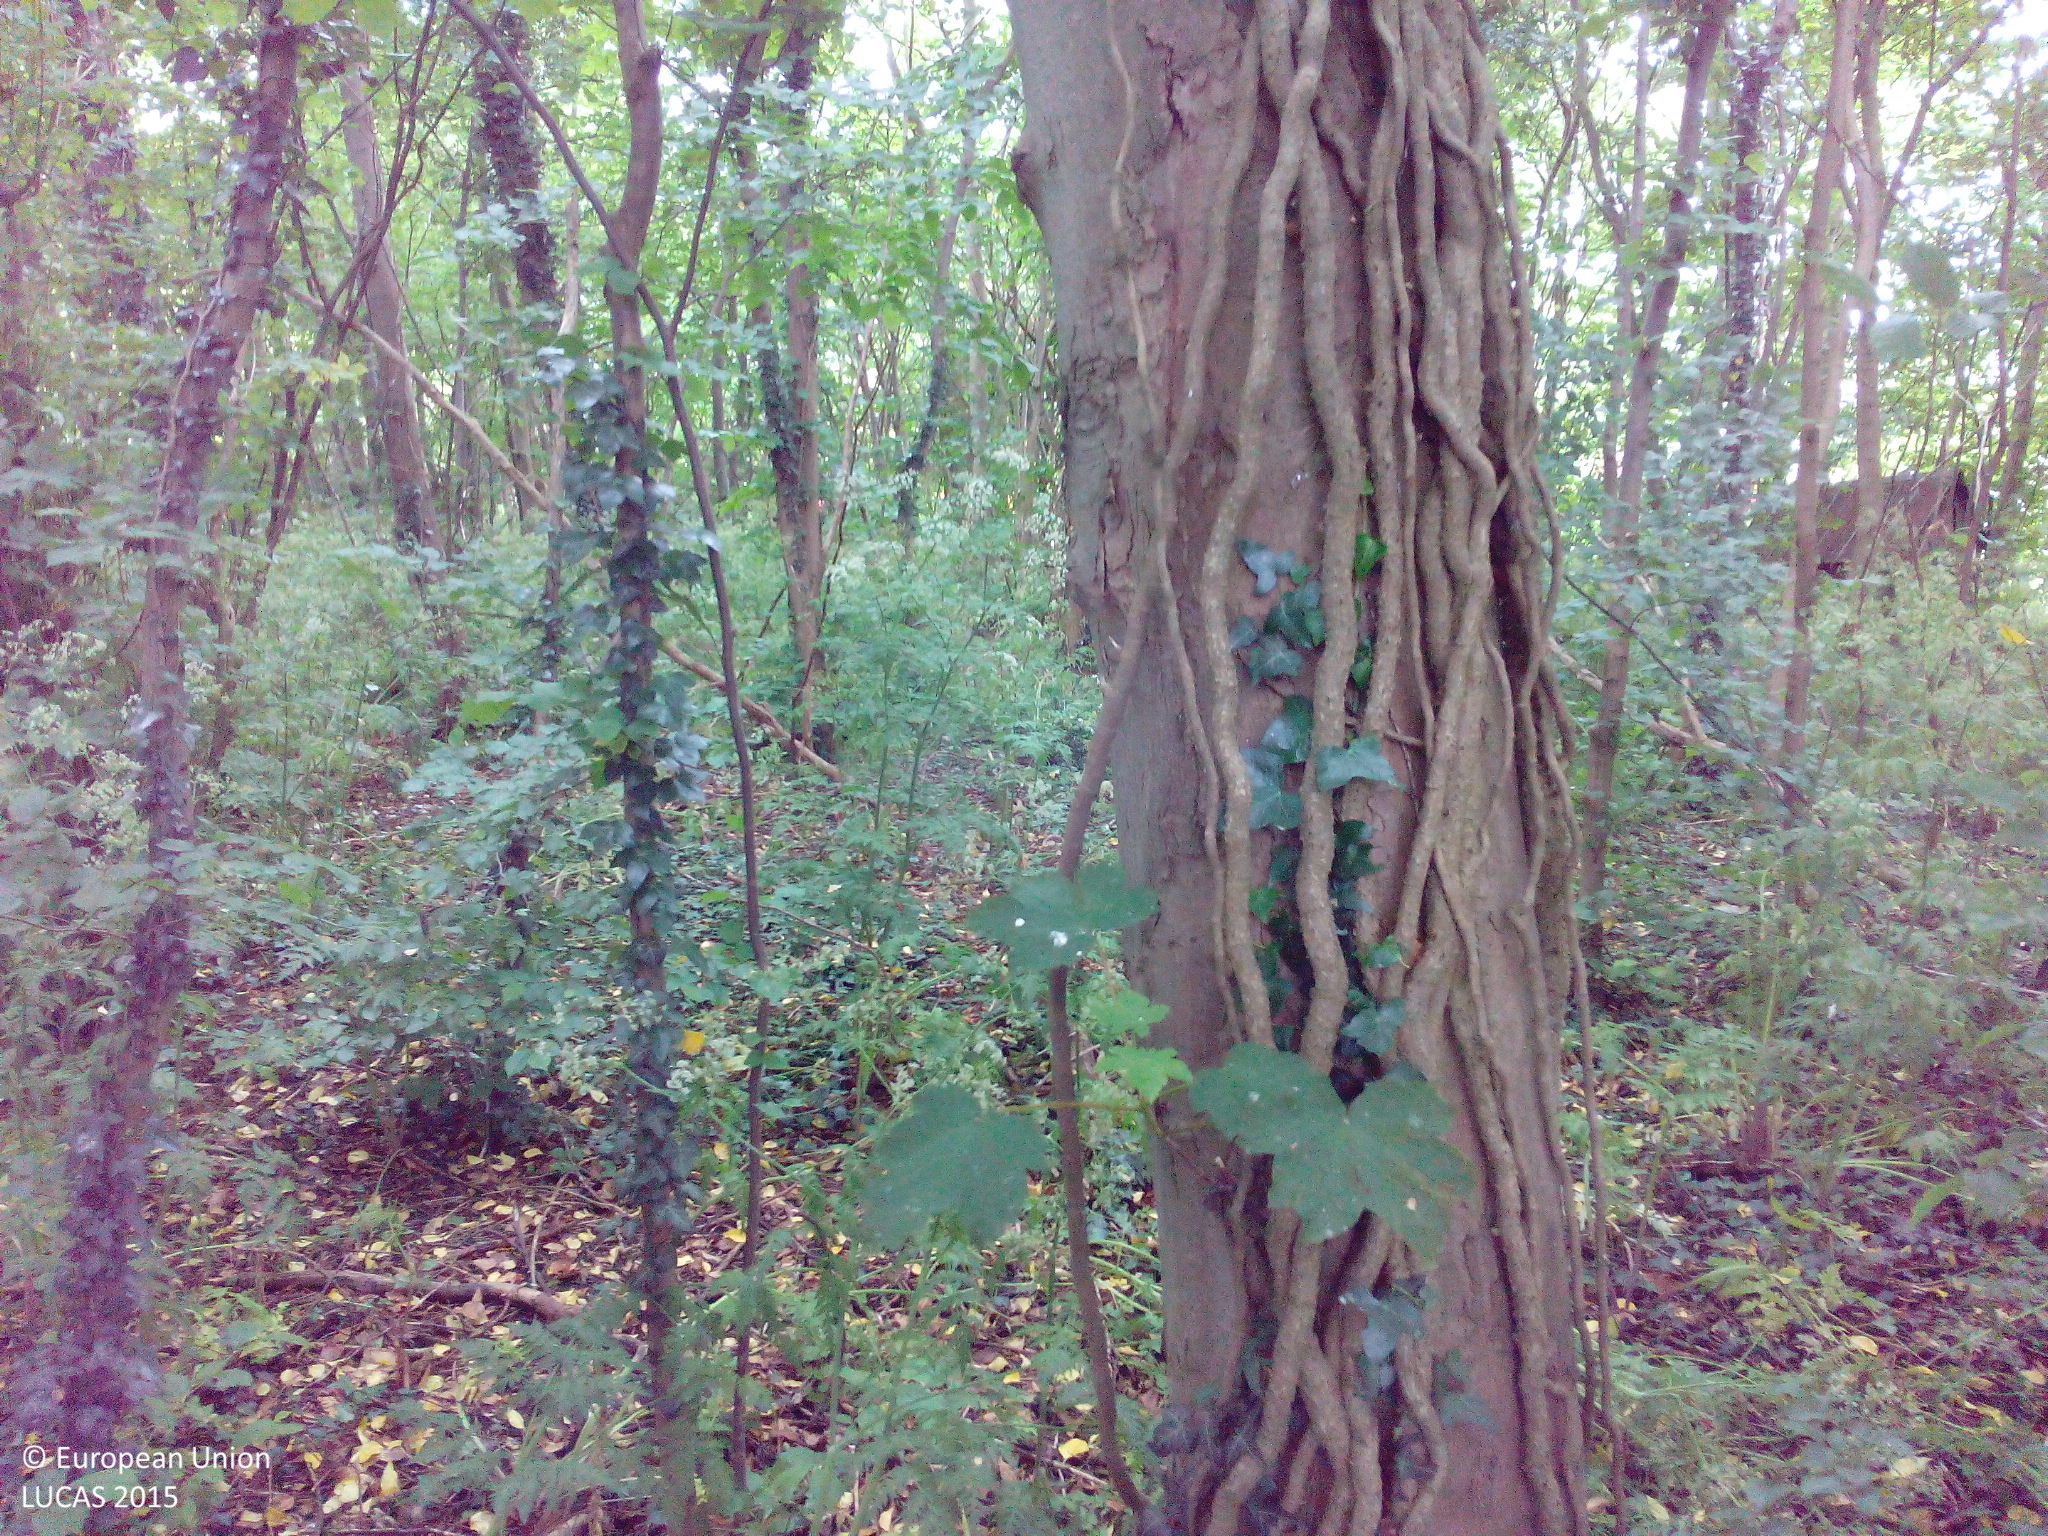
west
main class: Woodland
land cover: Broadleaved woodland
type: beech forest
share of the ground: > 75 %
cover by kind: broadleaved forest trees 100 %
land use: Residential
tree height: > 5 m
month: June
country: DK
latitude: 54.9452
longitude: 10.7644
